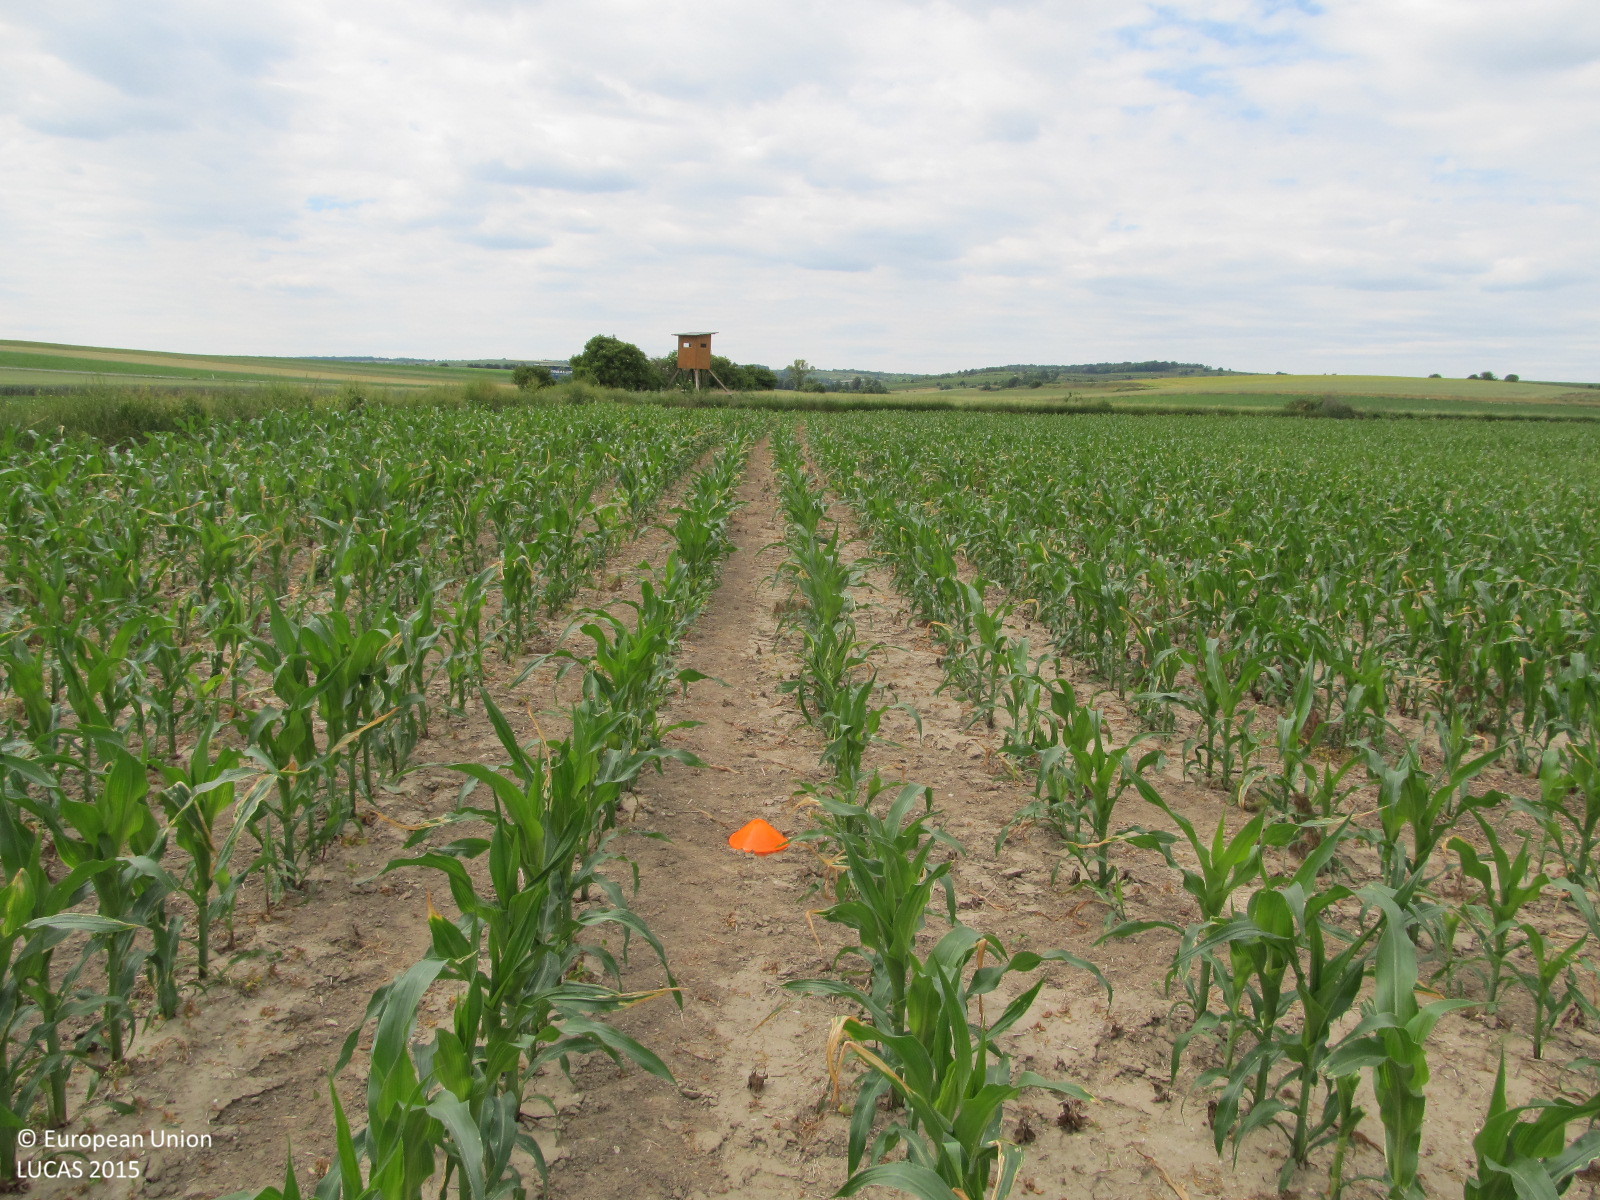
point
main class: Cropland
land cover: Maize
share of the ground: 25 - 50 %
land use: Agriculture (excluding fallow land and kitchen gardens)
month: June
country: AT
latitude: 48.4646
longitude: 15.8598
